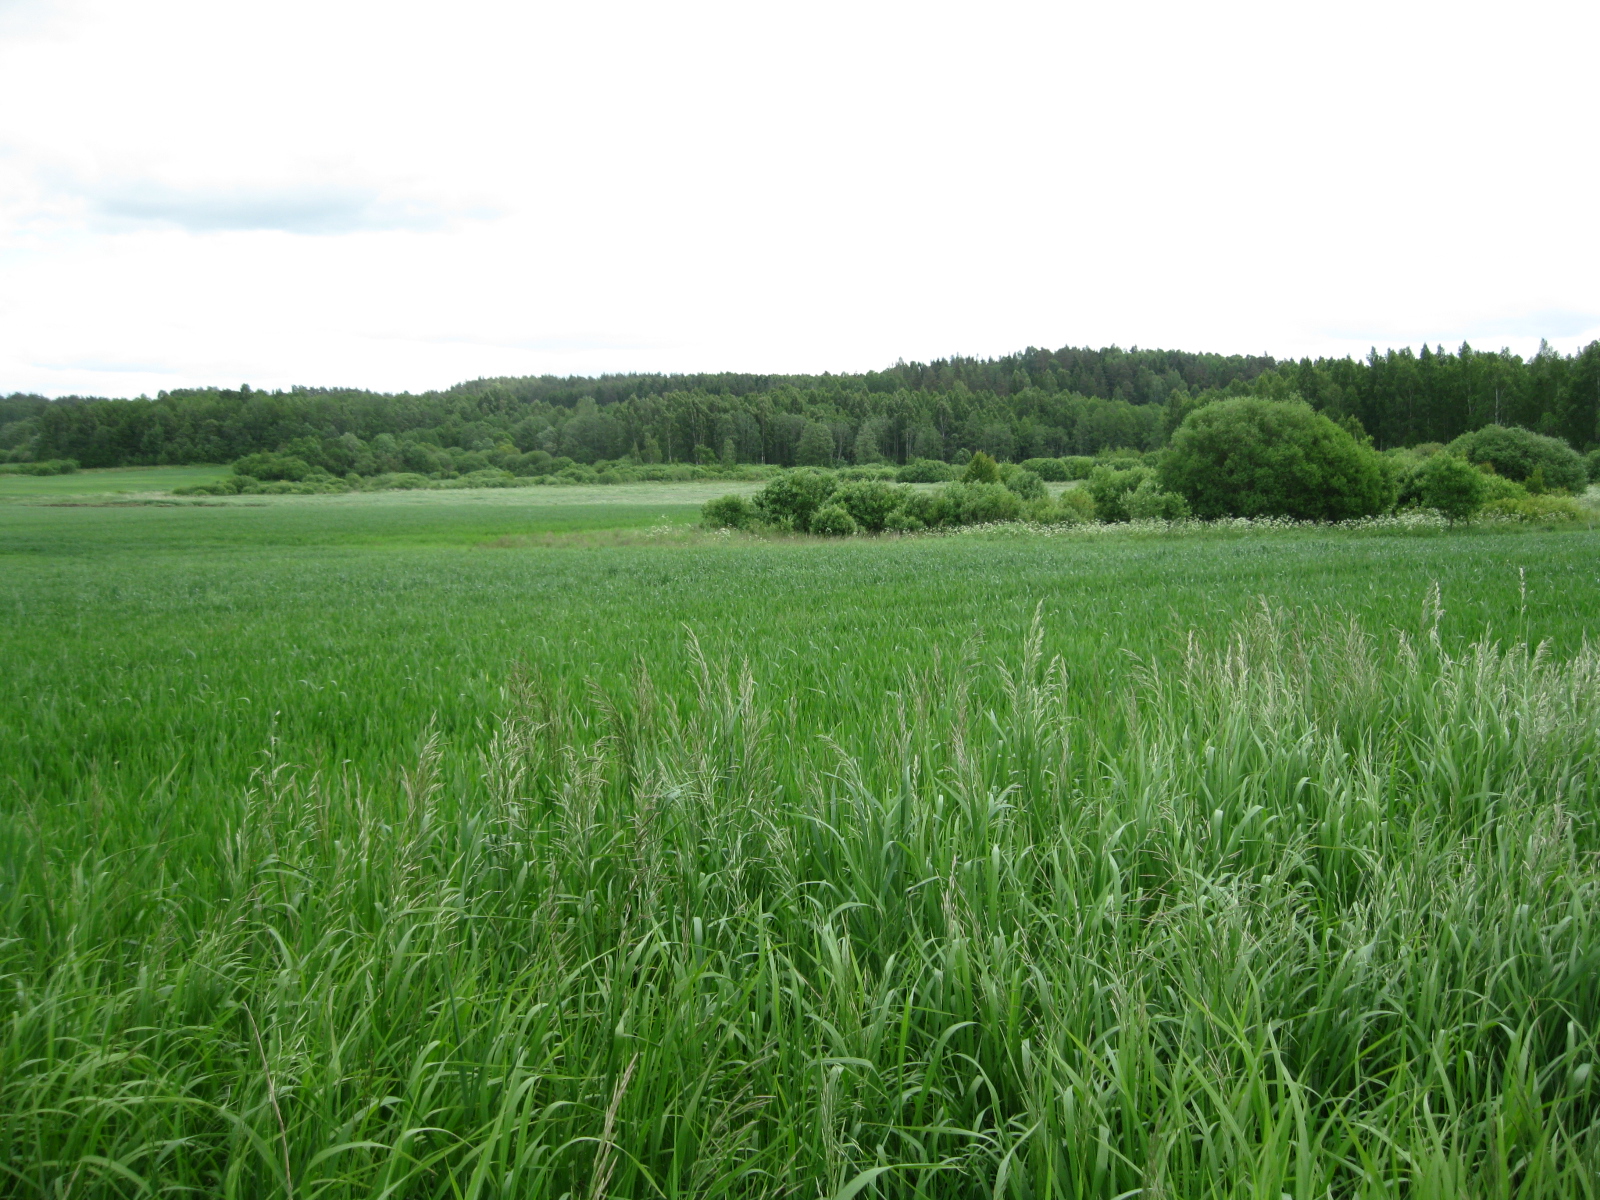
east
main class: Grassland
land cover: Spontaneously vegetated surfaces
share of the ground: > 75 %
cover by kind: herbaceous plants 100 %
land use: Fallow land
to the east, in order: Spontaneously vegetated surfaces; Abandoned hedges; Ditches and canals; Grassland with sparse tree/shrub cover; Common wheat; Spontaneously vegetated surfaces; Common wheat; Other bare soil; Grassland without tree/shrub cover
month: June
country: LT
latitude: 55.6475
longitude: 23.3762
